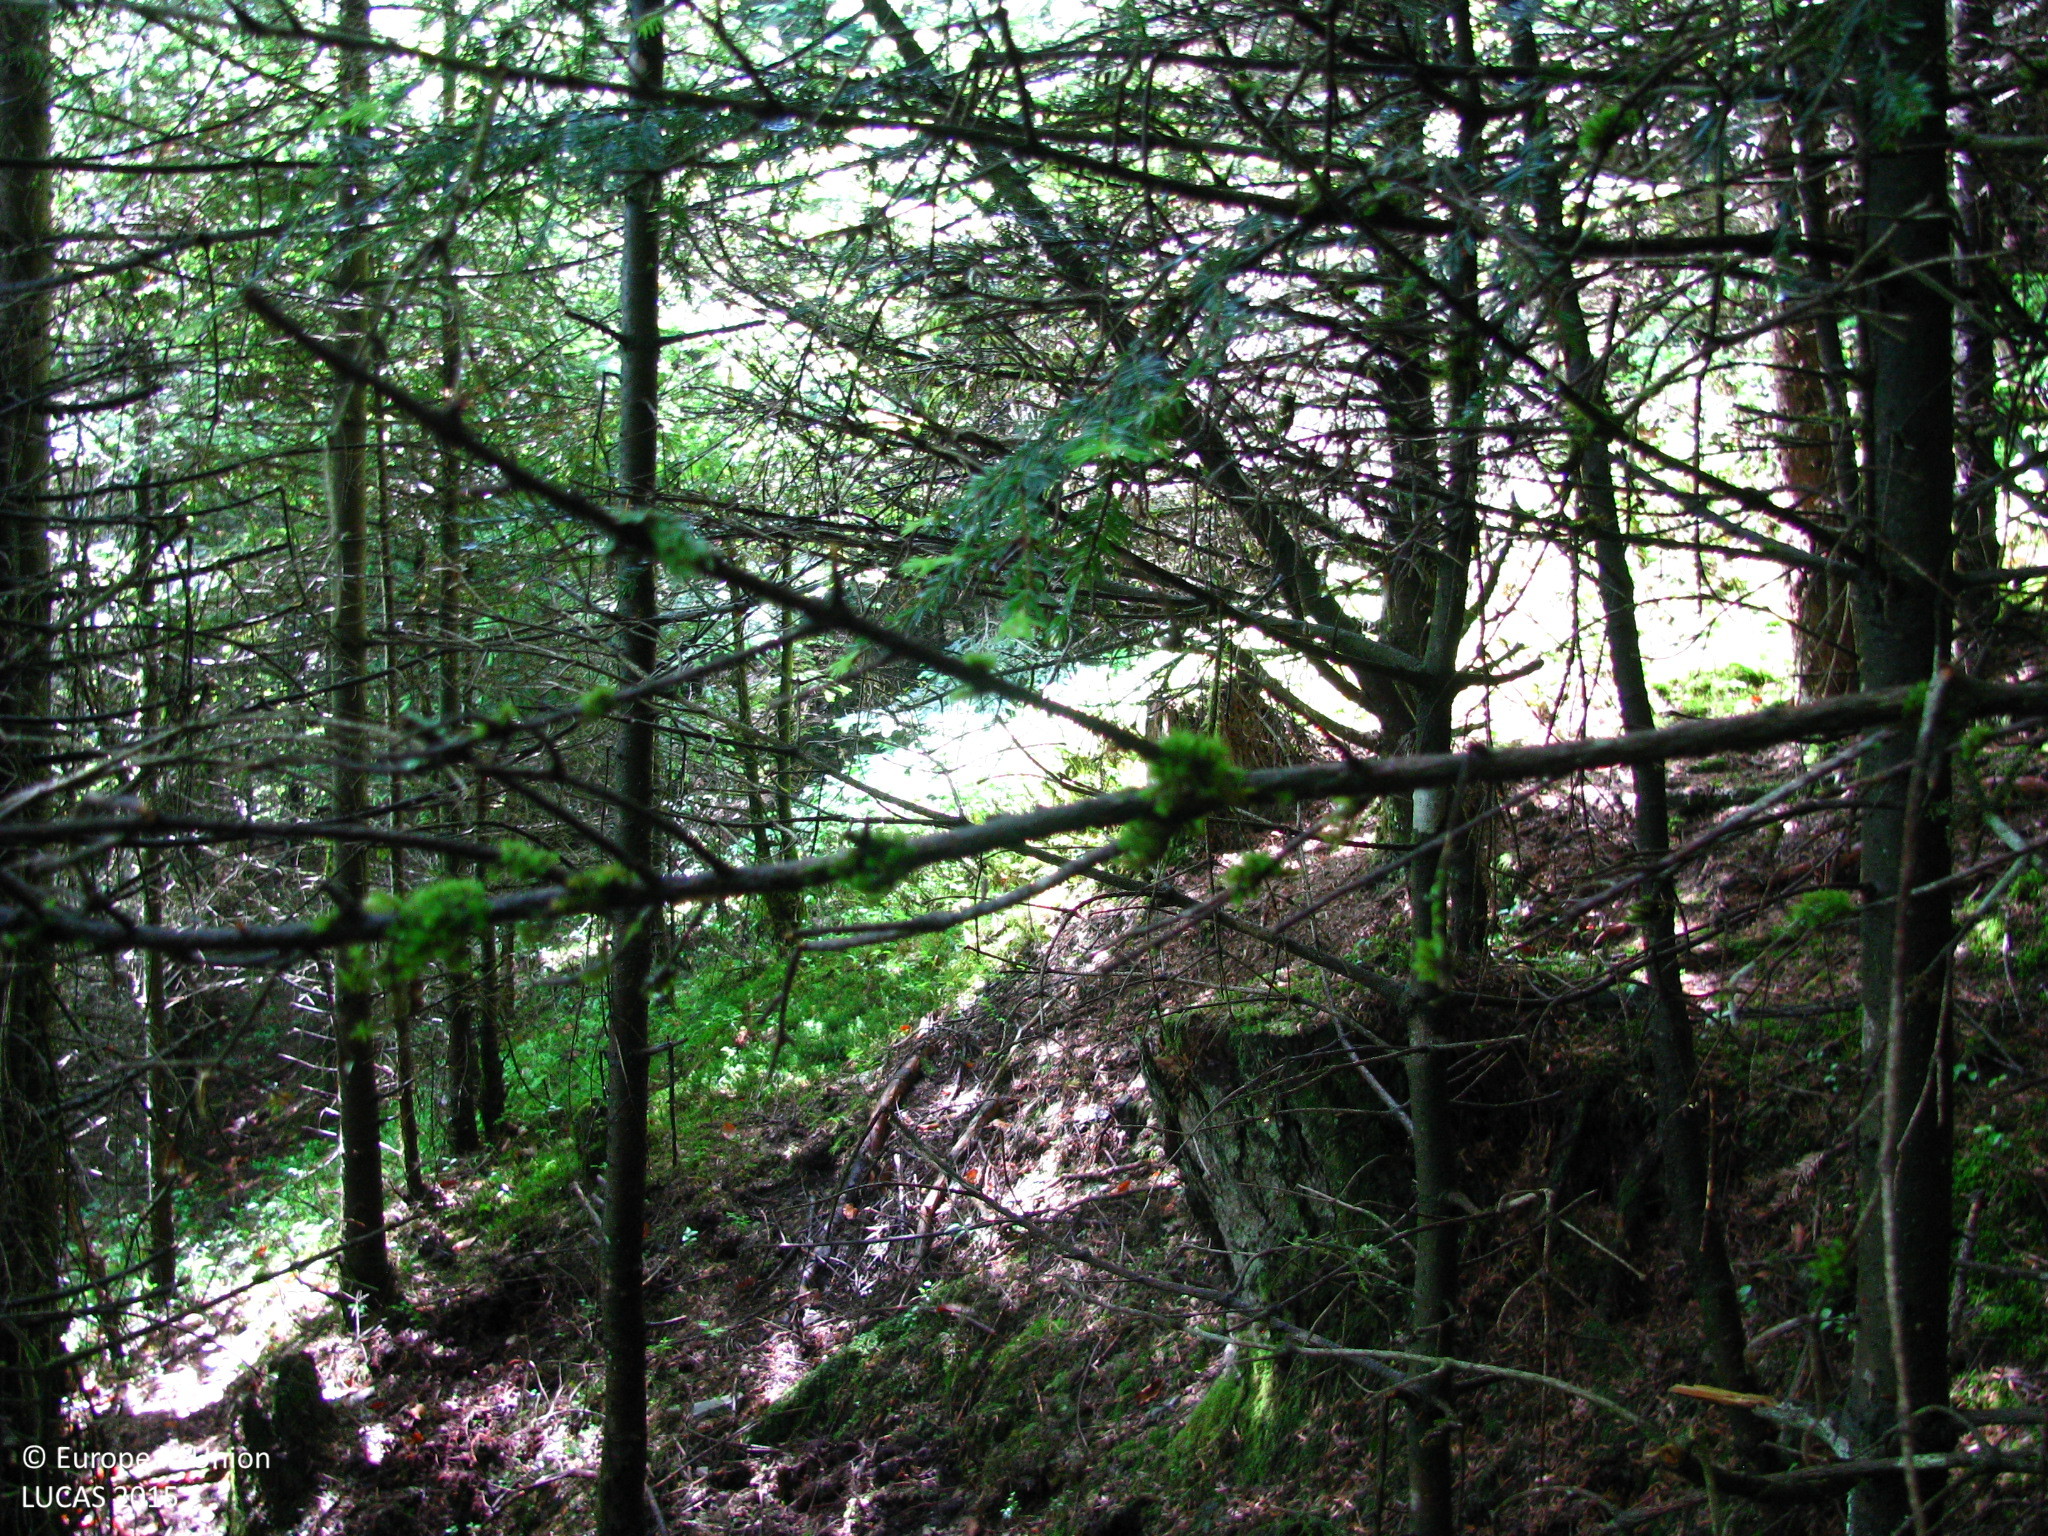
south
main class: Woodland
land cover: Other coniferous woodland
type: alpine coniferous forest
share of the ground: > 75 %
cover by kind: coniferous forest trees 90 %, broadleaved forest trees 5 %, herbaceous plants 5 %
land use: Forestry
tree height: > 5 m
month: May
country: AT
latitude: 47.5928
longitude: 14.4543
